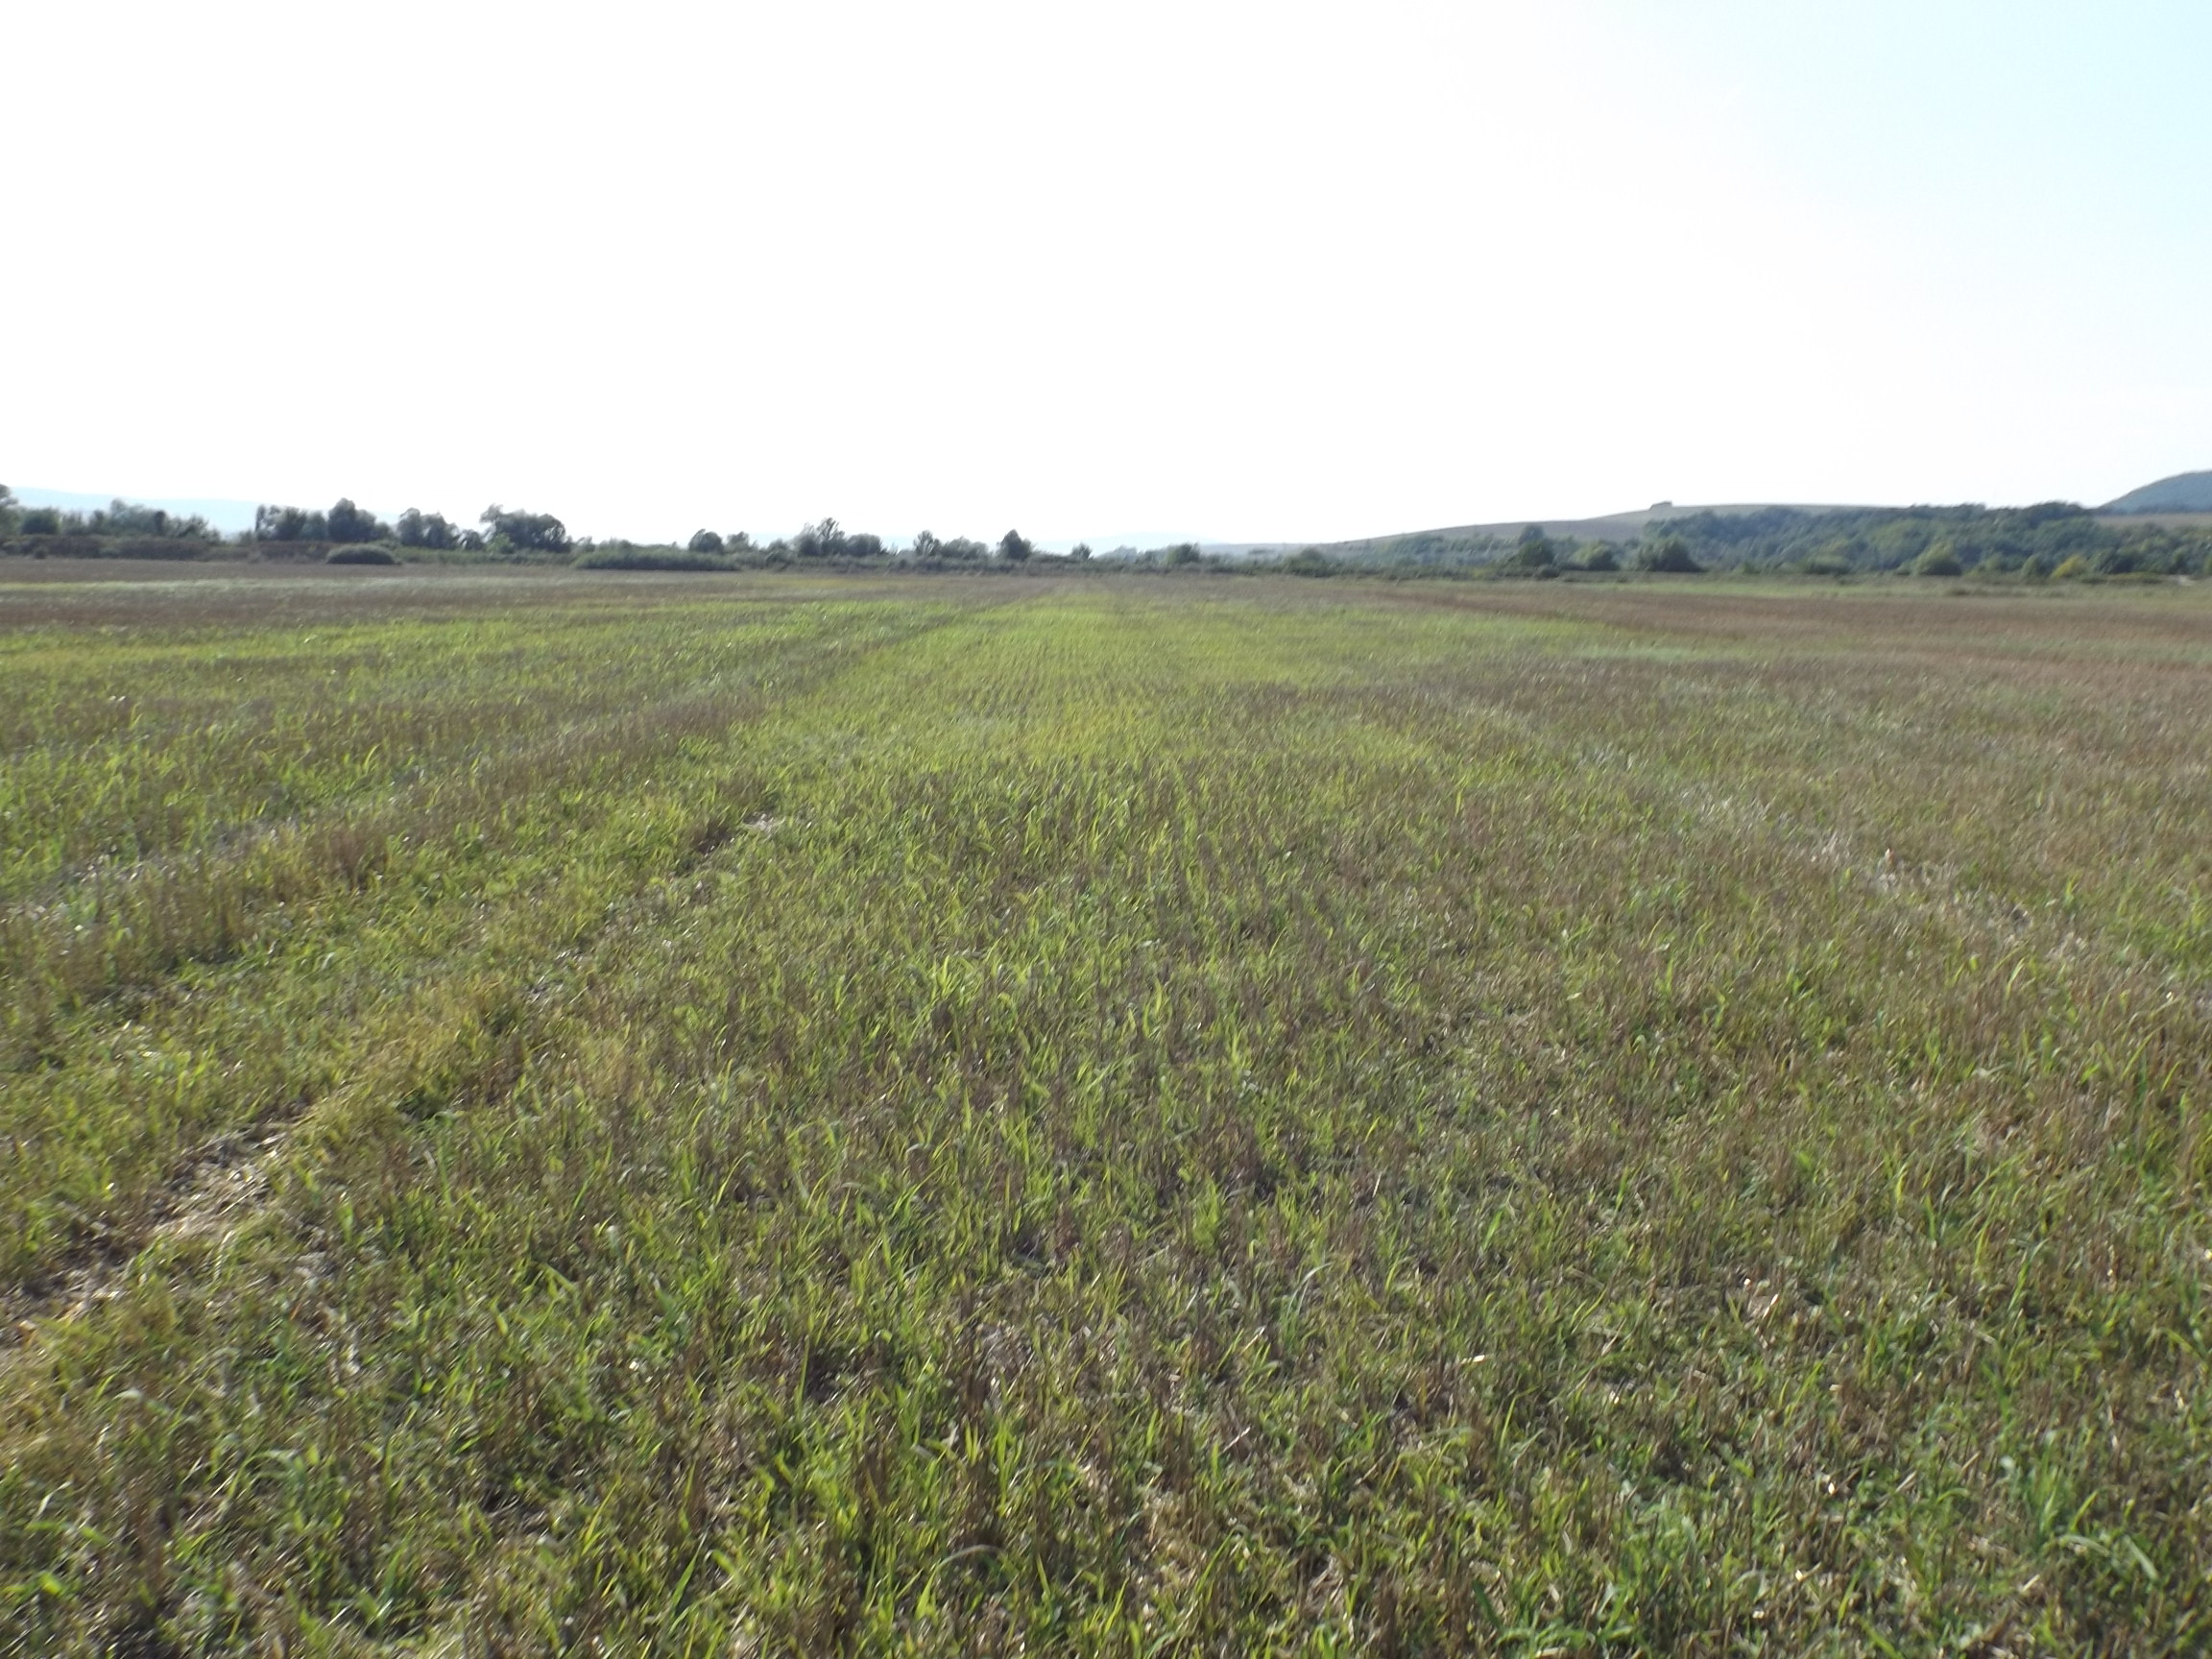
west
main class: Cropland
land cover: Common wheat
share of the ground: 25 - 50 %
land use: Agriculture (excluding fallow land and kitchen gardens)
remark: Harvested field
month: August
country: BG
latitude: 43.0515
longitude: 27.3961
